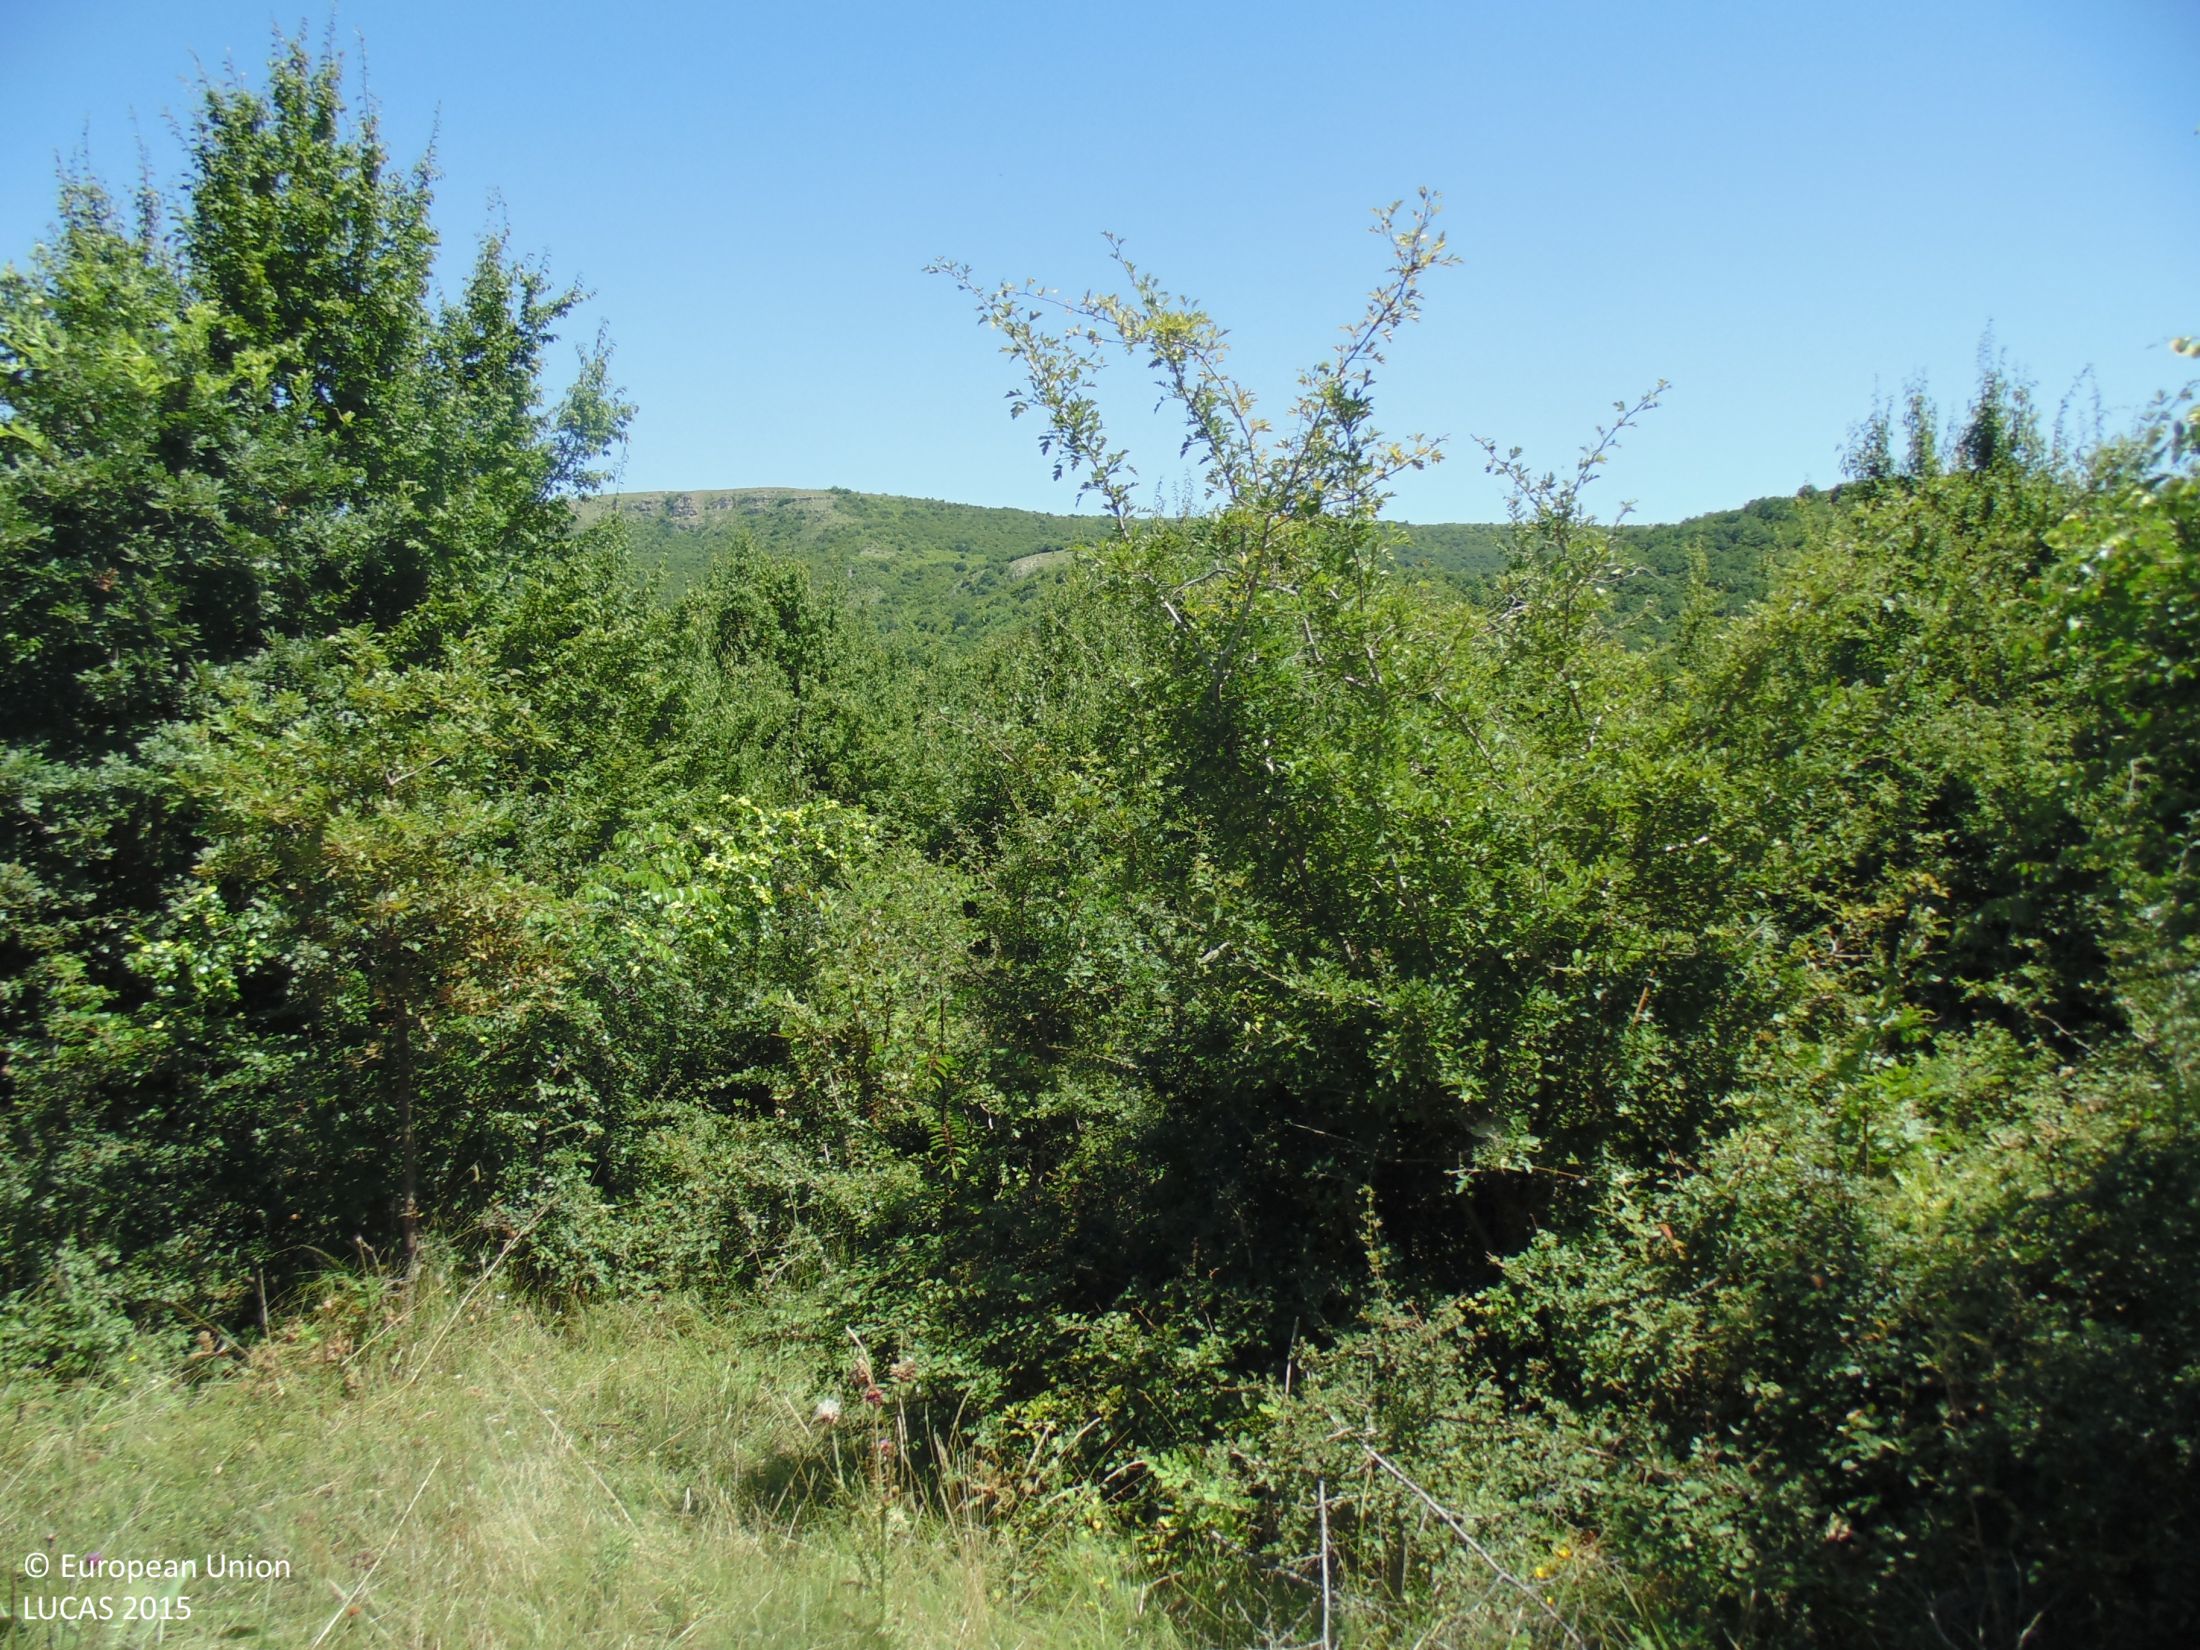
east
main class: Grassland
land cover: Grassland with sparse tree/shrub cover
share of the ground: > 75 %
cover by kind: herbaceous plants 90 %, broadleaved forest trees 5 %, shrubs 5 %
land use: Semi-natural and natural areas not in use
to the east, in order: Grassland with sparse tree/shrub cover; Broadleaved woodland; Shrubland with sparse tree cover; Tracks; Shrubland with sparse tree cover; Grassland without tree/shrub cover; Fences; Grassland with sparse tree/shrub cover; Tracks; Grassland with sparse tree/shrub cover; Broadleaved woodland
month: July
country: BG
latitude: 43.4171
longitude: 28.0417
